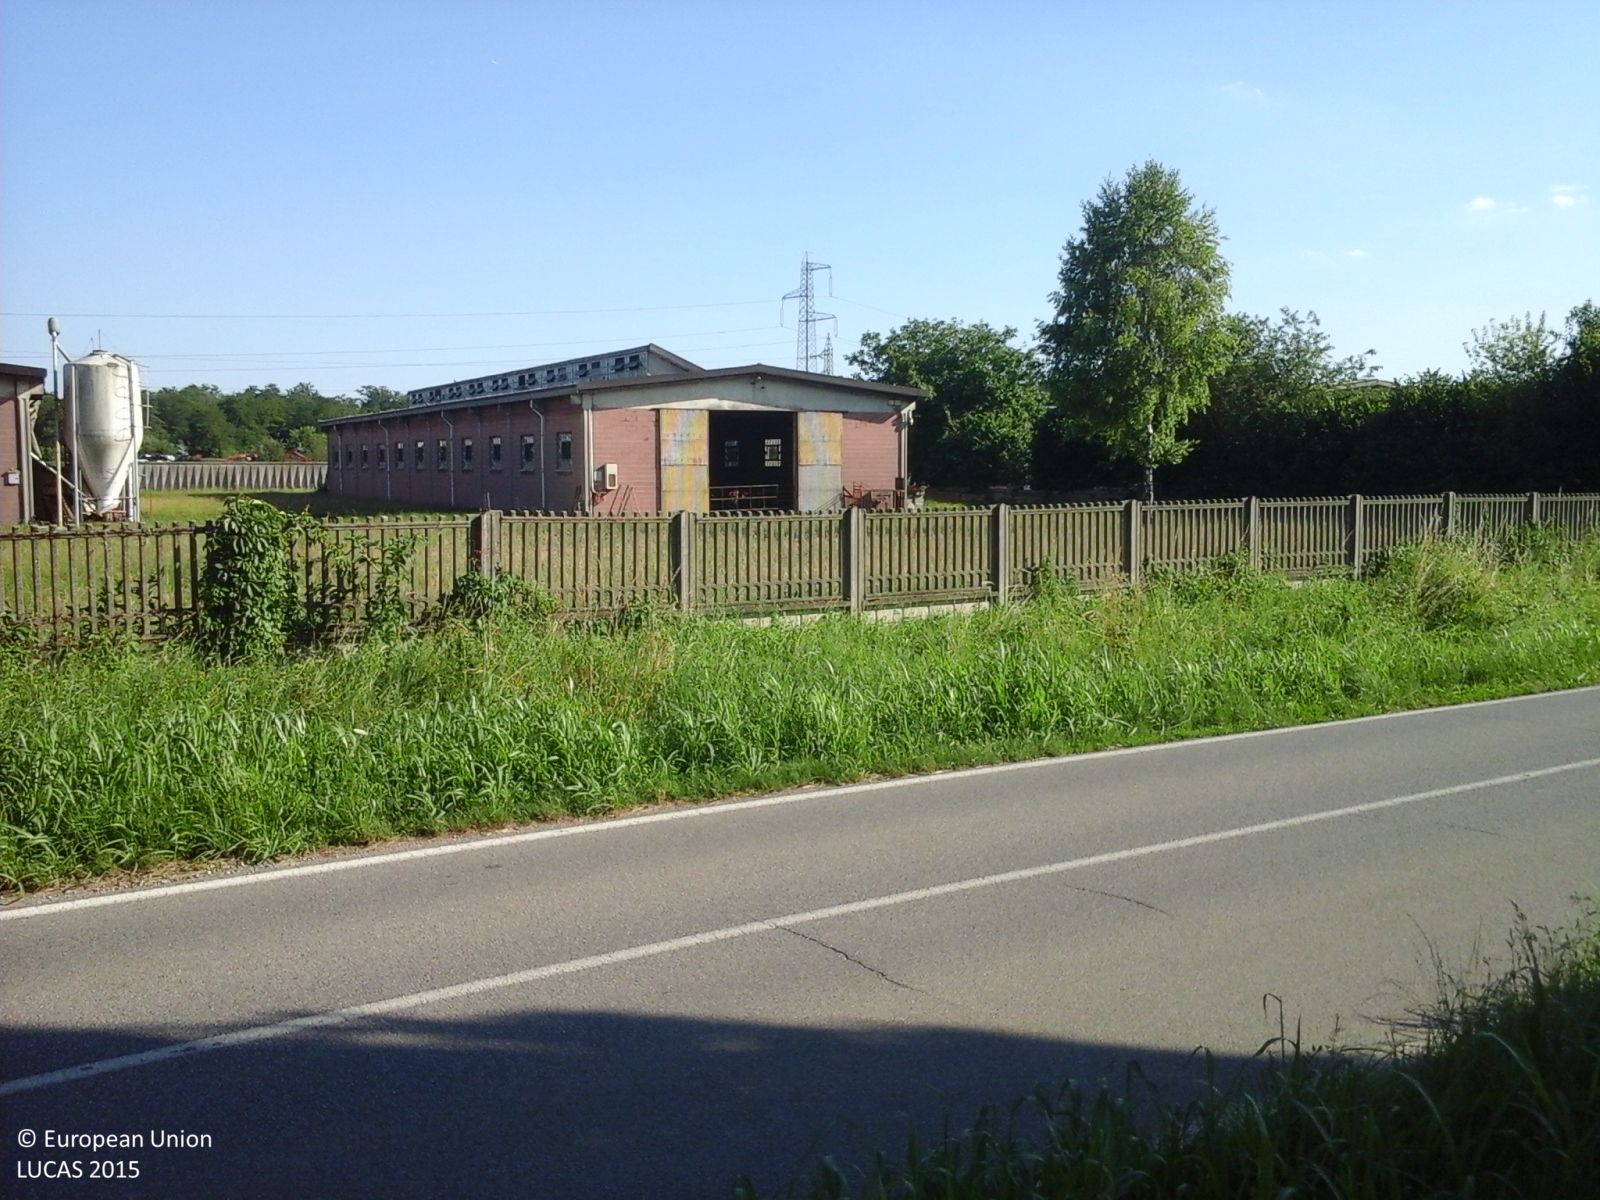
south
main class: Woodland
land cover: Pine dominated coniferous woodland
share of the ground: > 75 %
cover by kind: coniferous forest trees 95 %, herbaceous plants 5 %
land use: Residential
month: June
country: IT
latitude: 45.6459
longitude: 9.2442
